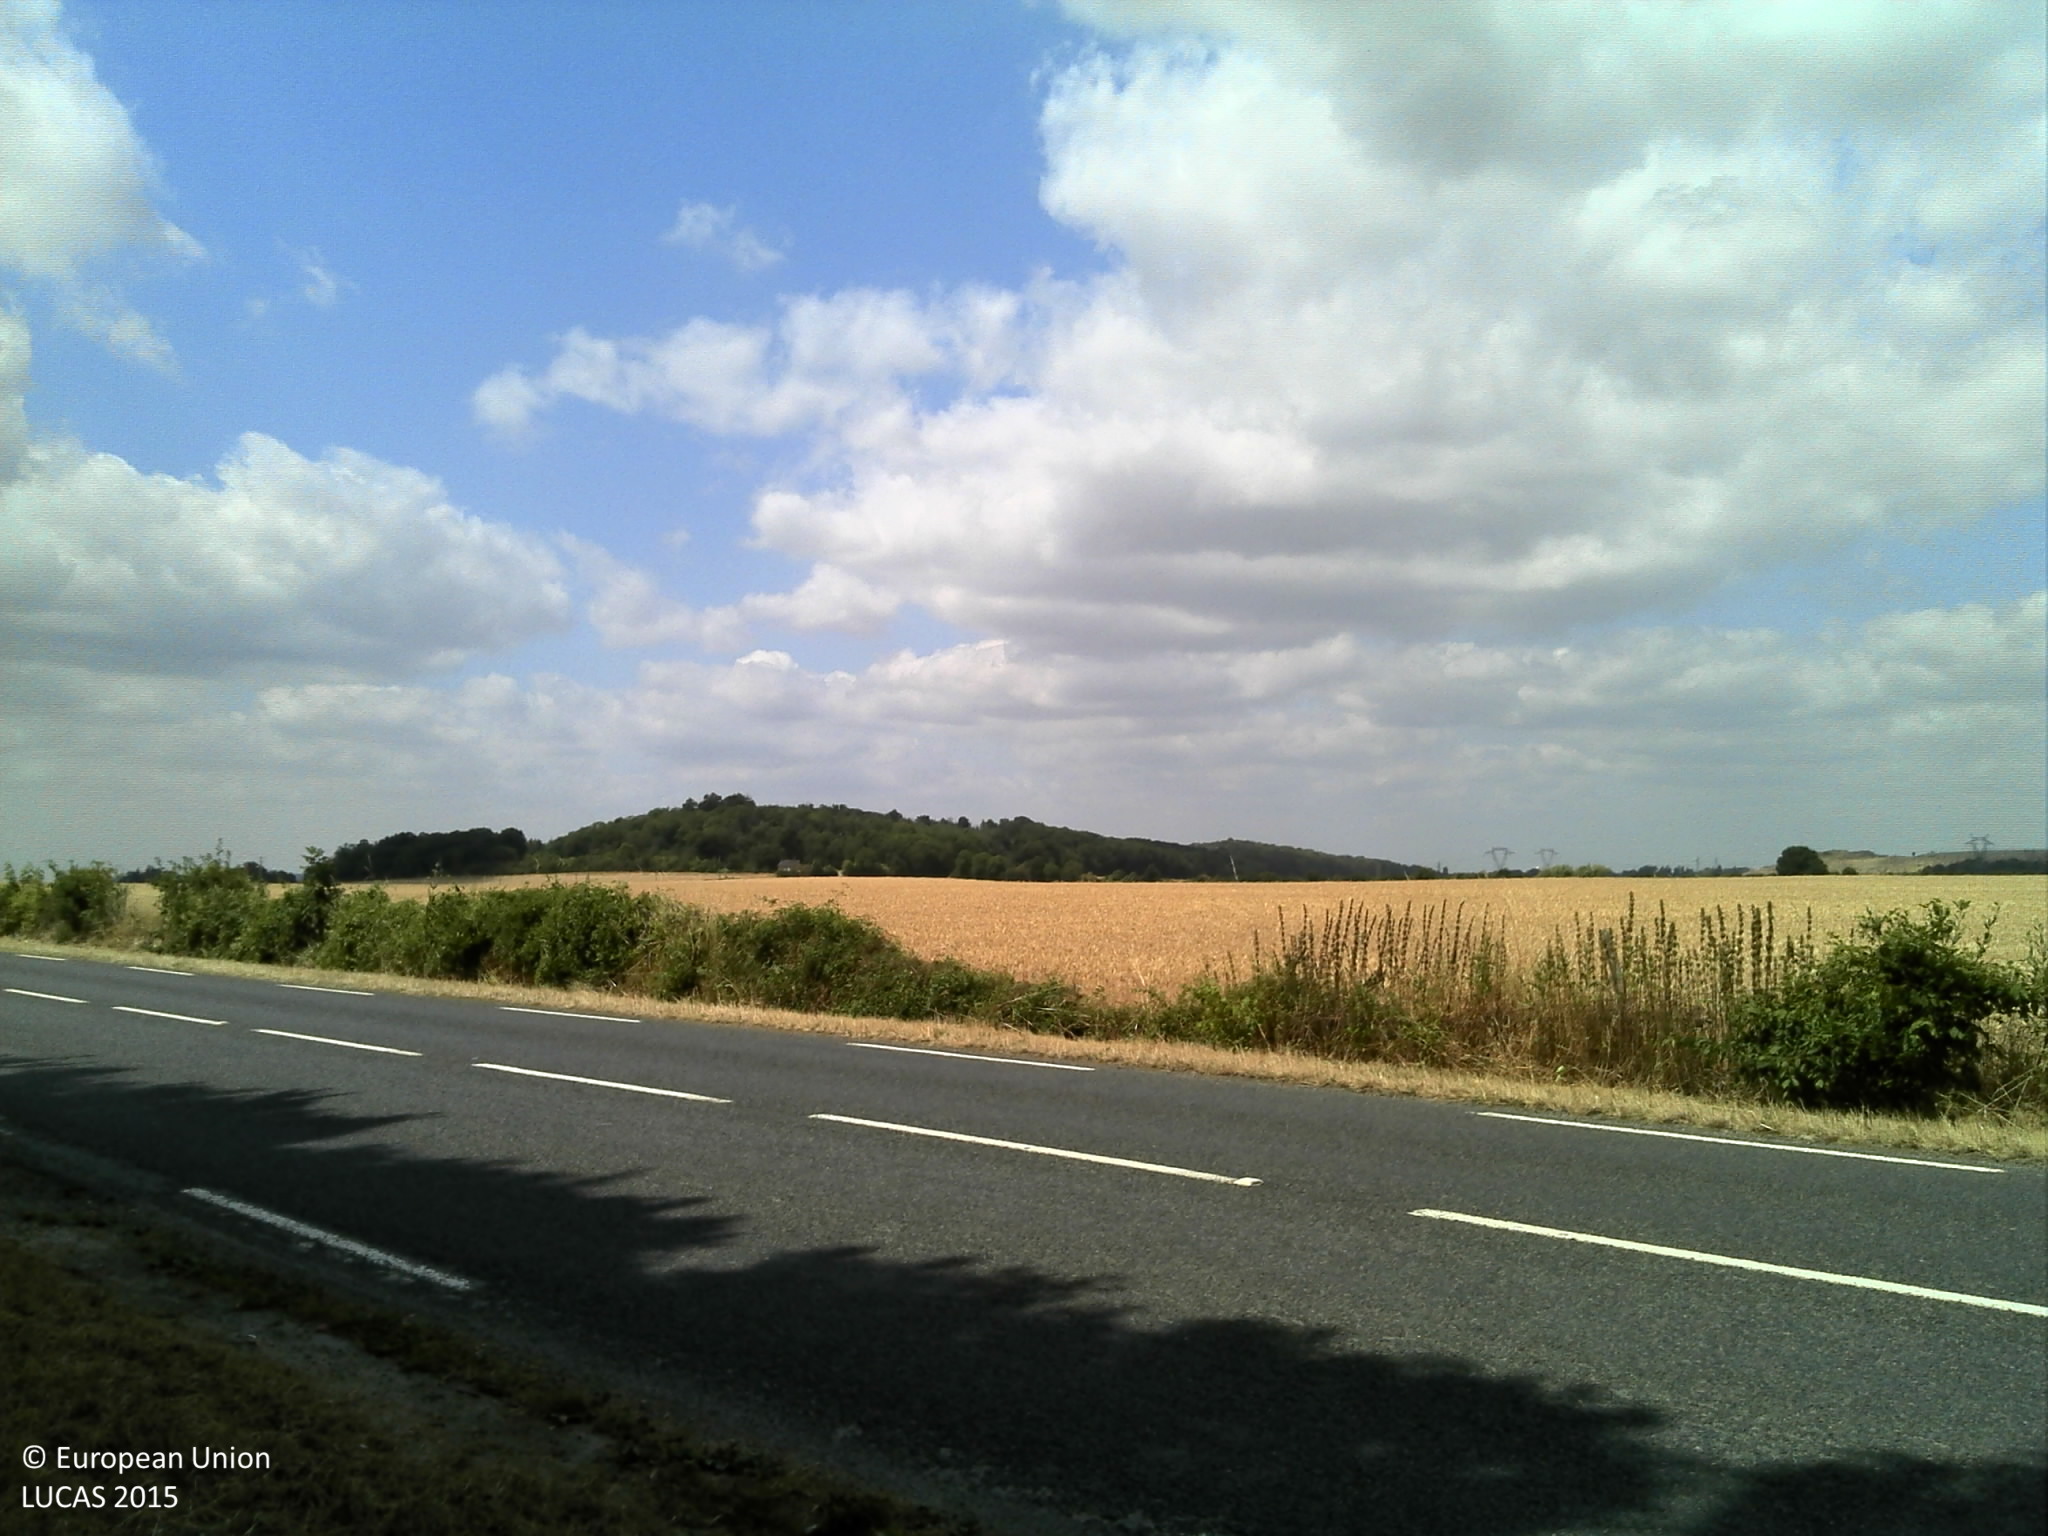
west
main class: Woodland
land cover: Broadleaved woodland
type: beech forest
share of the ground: > 75 %
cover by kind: broadleaved forest trees 100 %
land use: Forestry
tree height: > 5 m
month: July
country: FR
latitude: 48.5763
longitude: 2.4120
